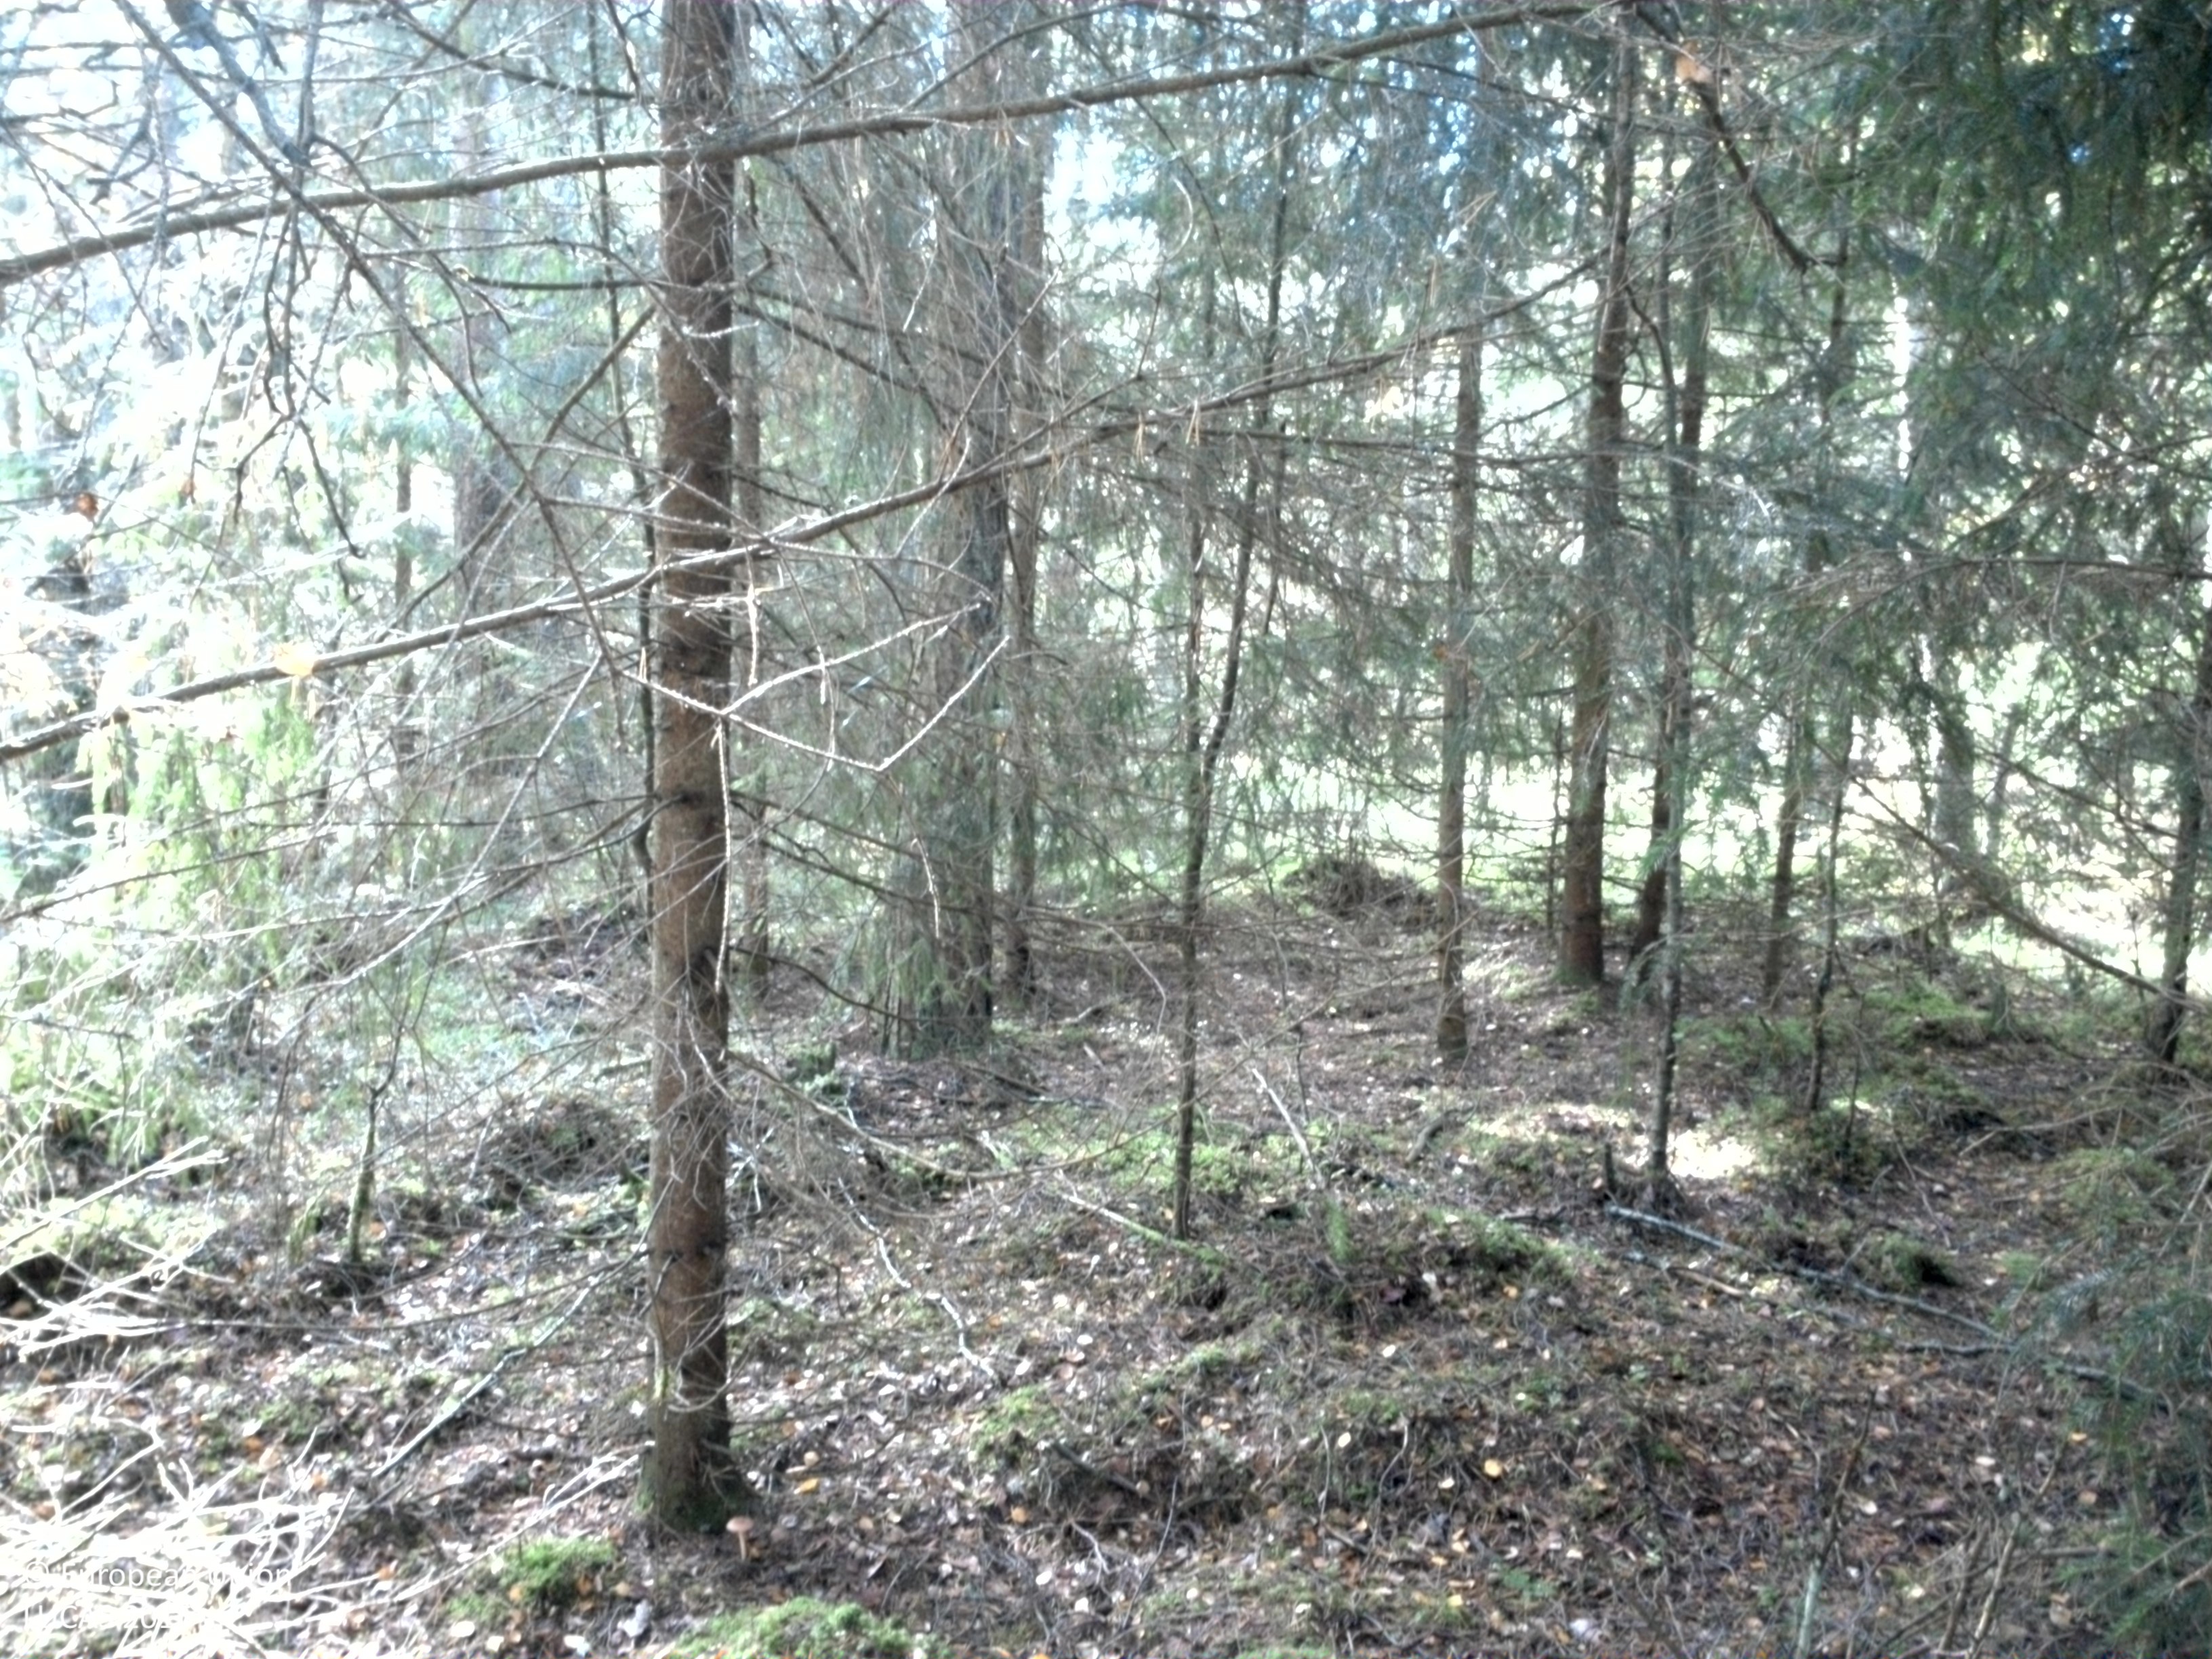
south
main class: Woodland
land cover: Pine dominated coniferous woodland
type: boreal forest
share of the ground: > 75 %
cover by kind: coniferous forest trees 85 %, broadleaved forest trees 5 %, shrubs 5 %, lichens and mosses 5 %
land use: Forestry
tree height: > 5 m
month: September
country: SE
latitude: 58.0032
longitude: 13.1253
